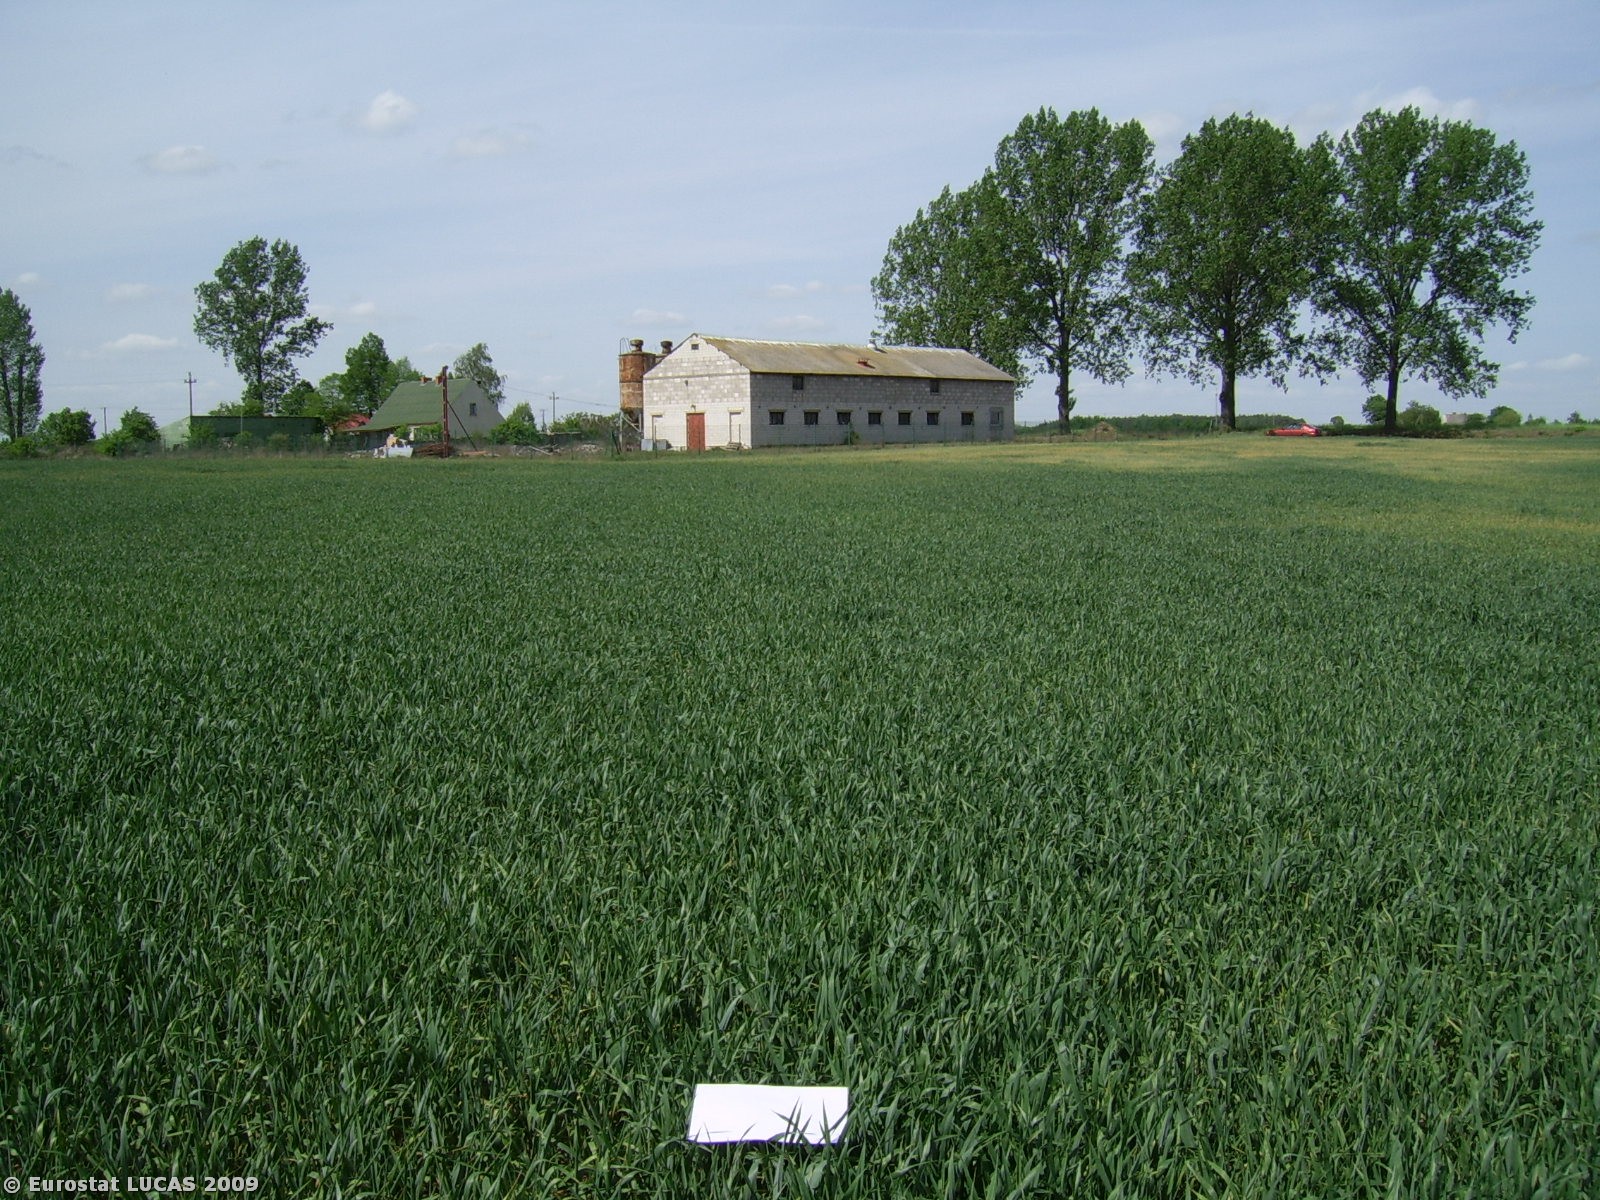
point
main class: Cropland
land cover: Common wheat
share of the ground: > 75 %
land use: Agriculture (excluding fallow land and kitchen gardens)
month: May
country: PL
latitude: 52.7290
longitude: 17.6094
